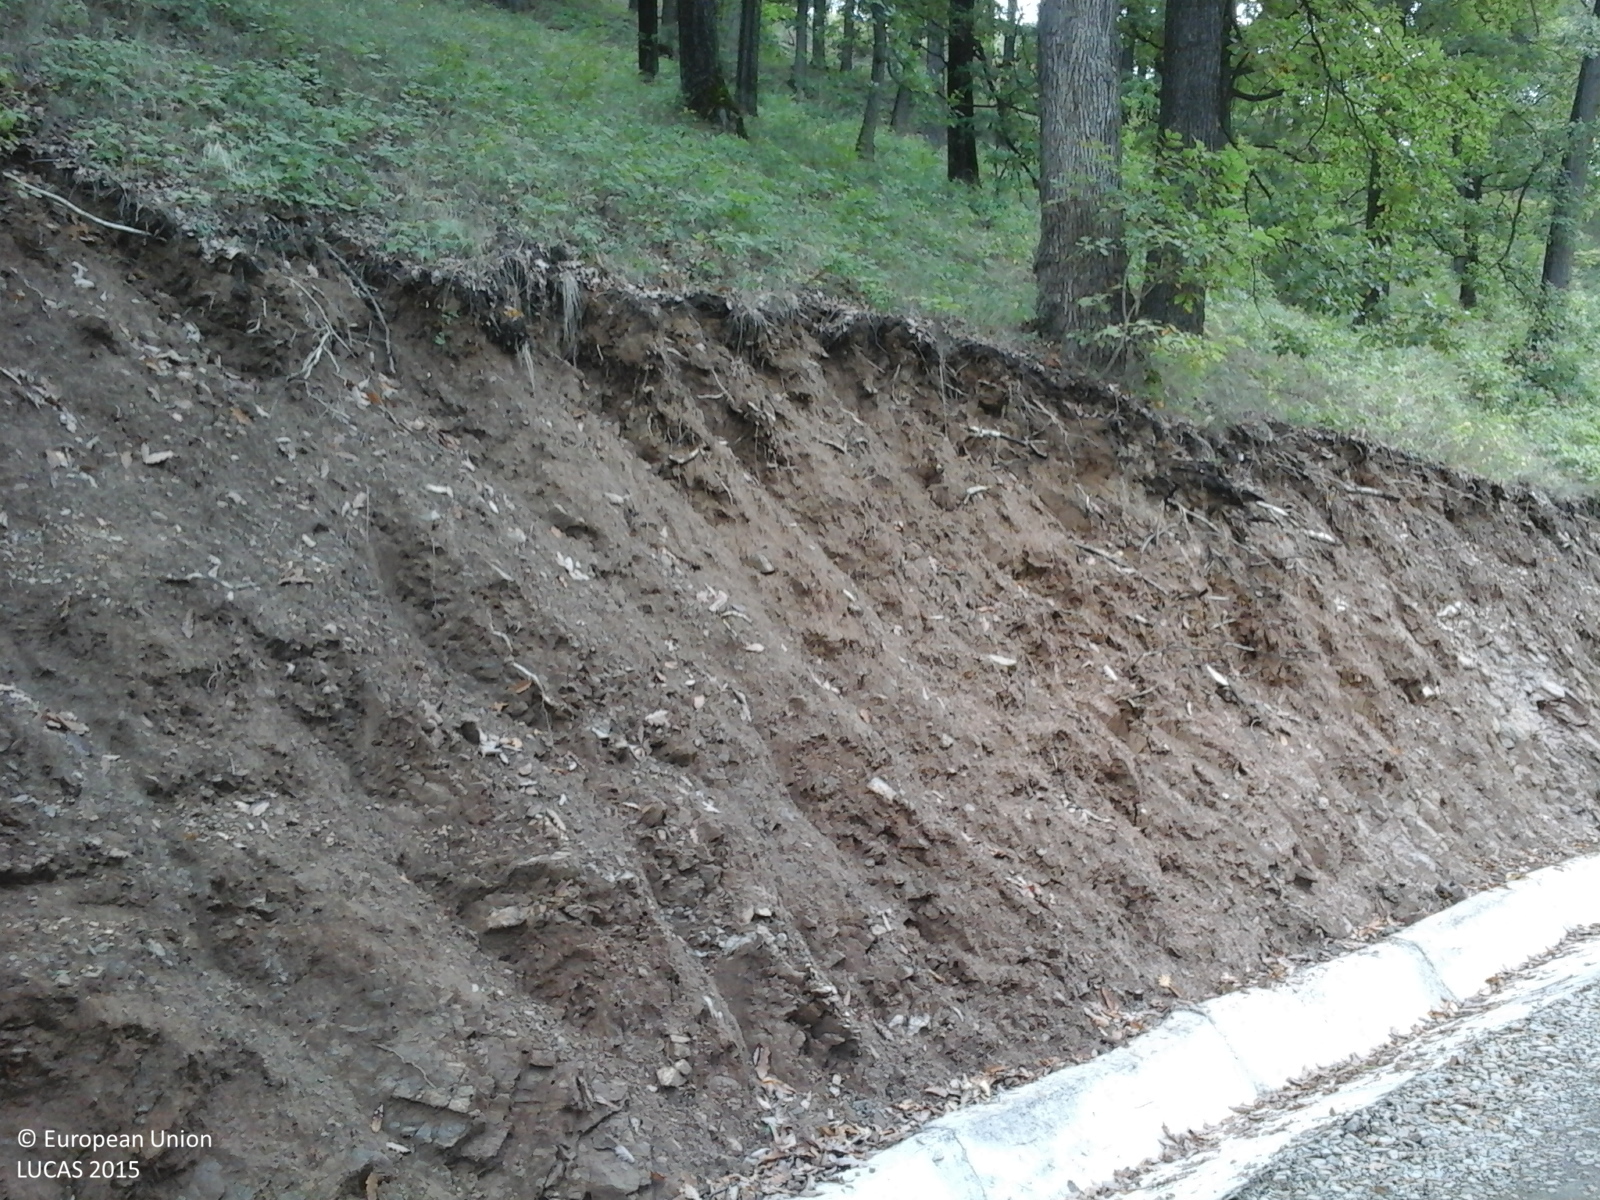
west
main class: Woodland
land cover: Broadleaved woodland
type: acidophilous oak and oak-birch forest
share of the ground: > 75 %
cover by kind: broadleaved forest trees 100 %
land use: Forestry
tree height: > 5 m
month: September
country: RO
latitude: 45.7659
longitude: 23.6307
